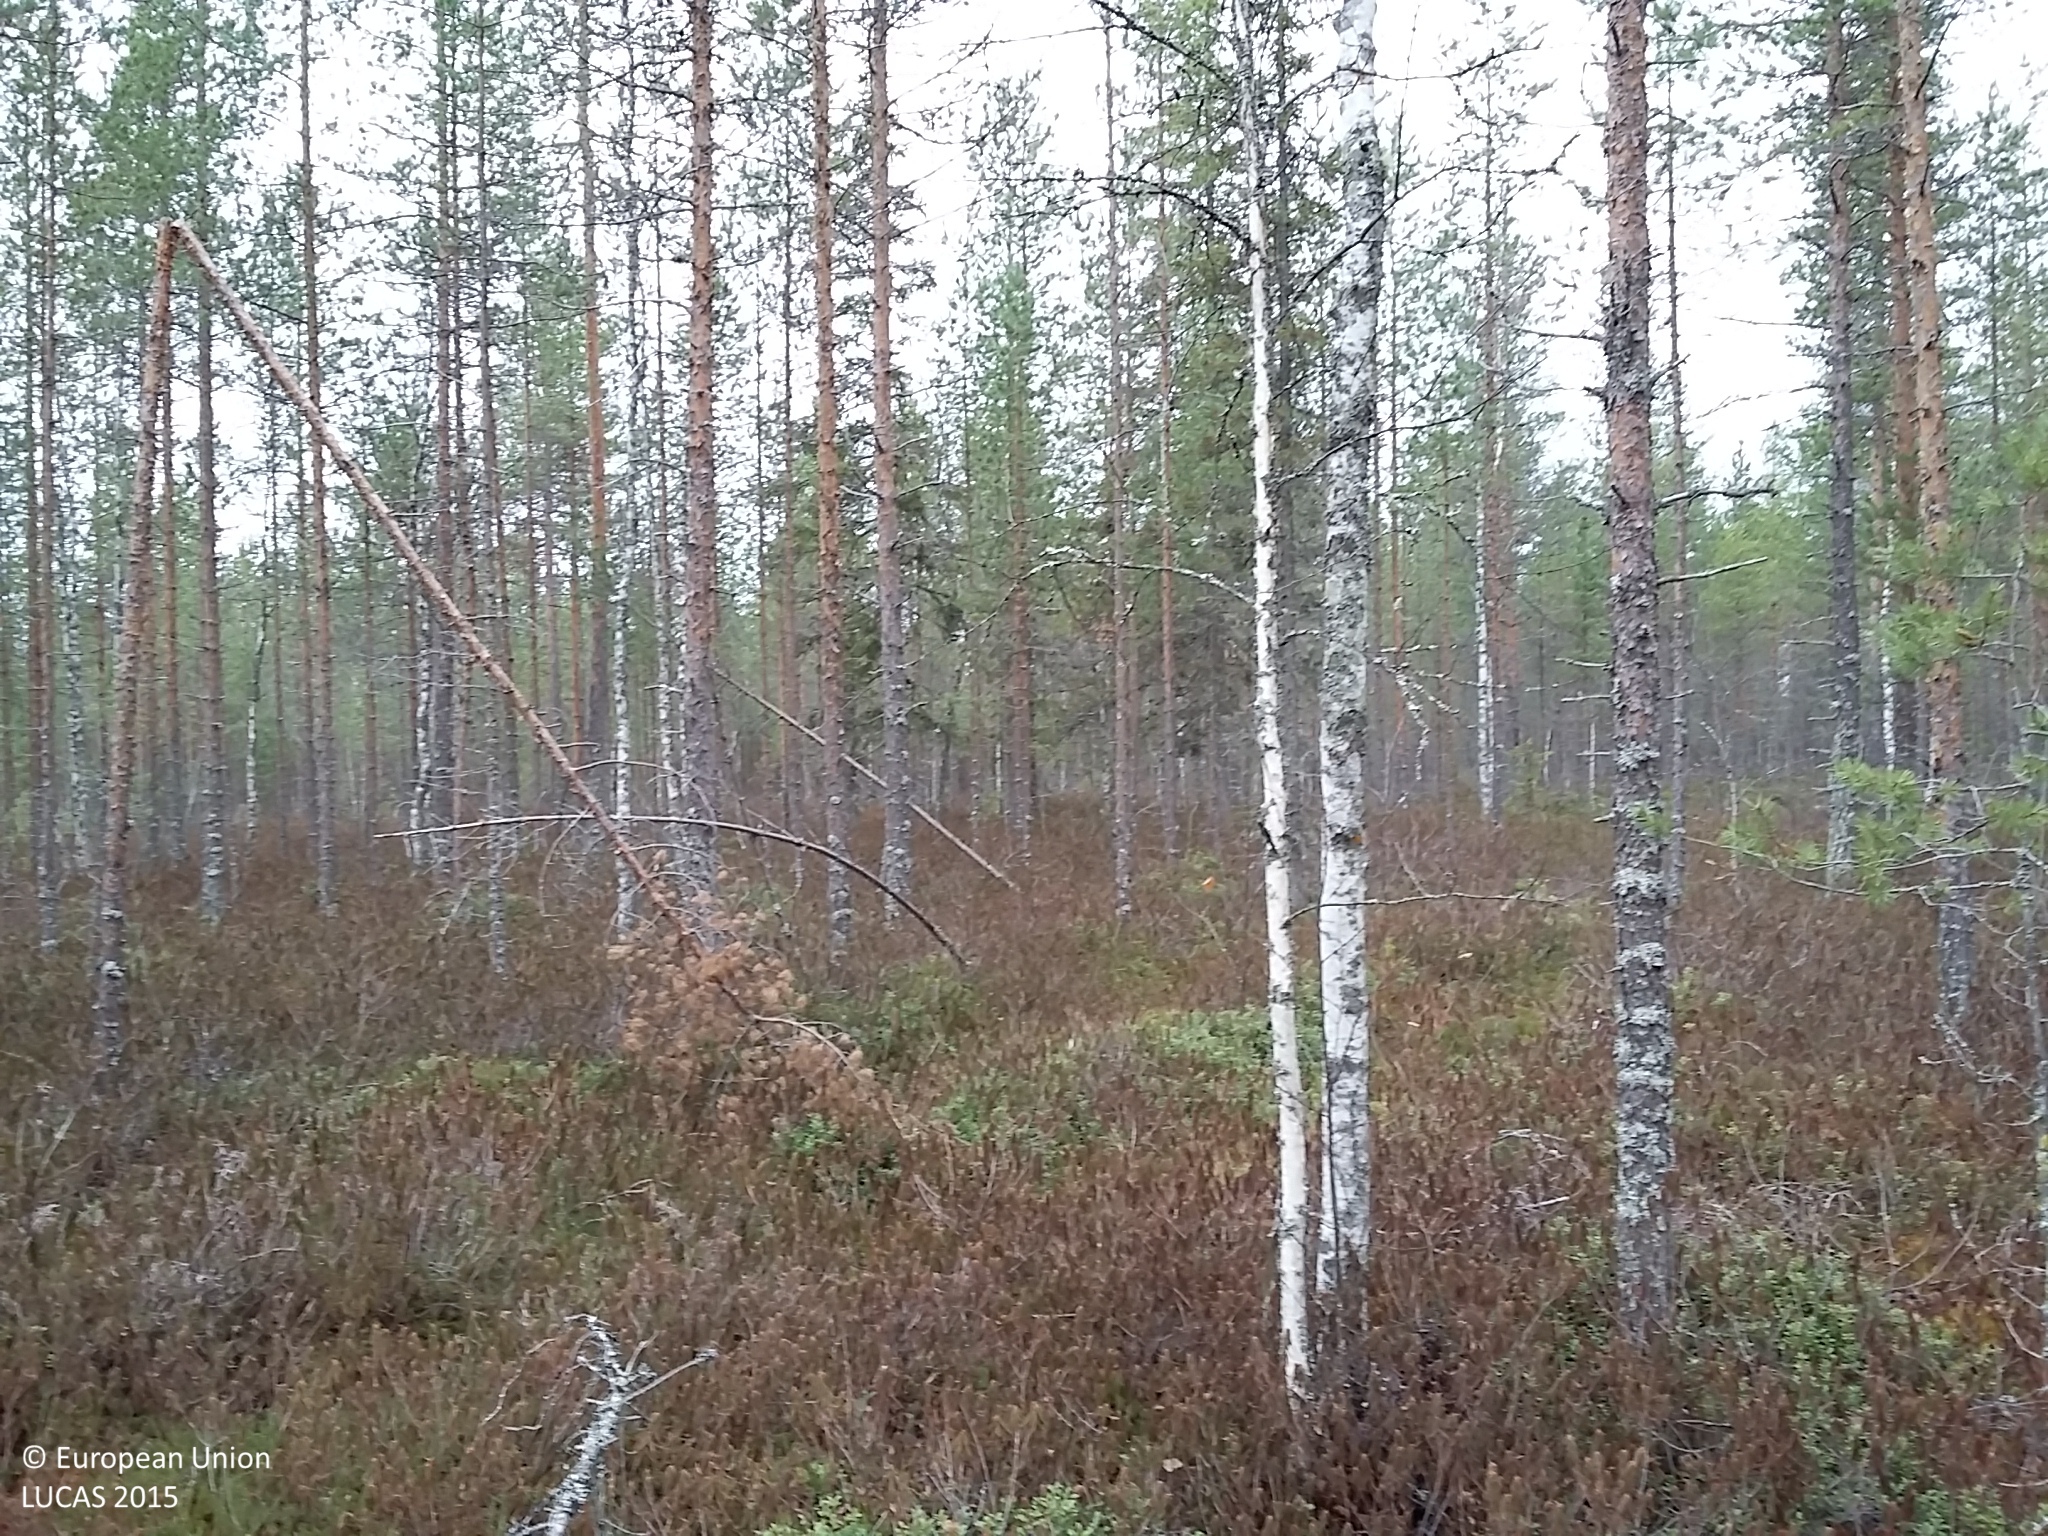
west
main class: Woodland
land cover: Pine dominated mixed woodland
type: boreal forest
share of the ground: > 75 %
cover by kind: coniferous forest trees 55 %, broadleaved forest trees 25 %, shrubs 10 %, lichens and mosses 10 %
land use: Forestry
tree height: > 5 m
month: October
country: FI
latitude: 64.4271
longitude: 25.4758
